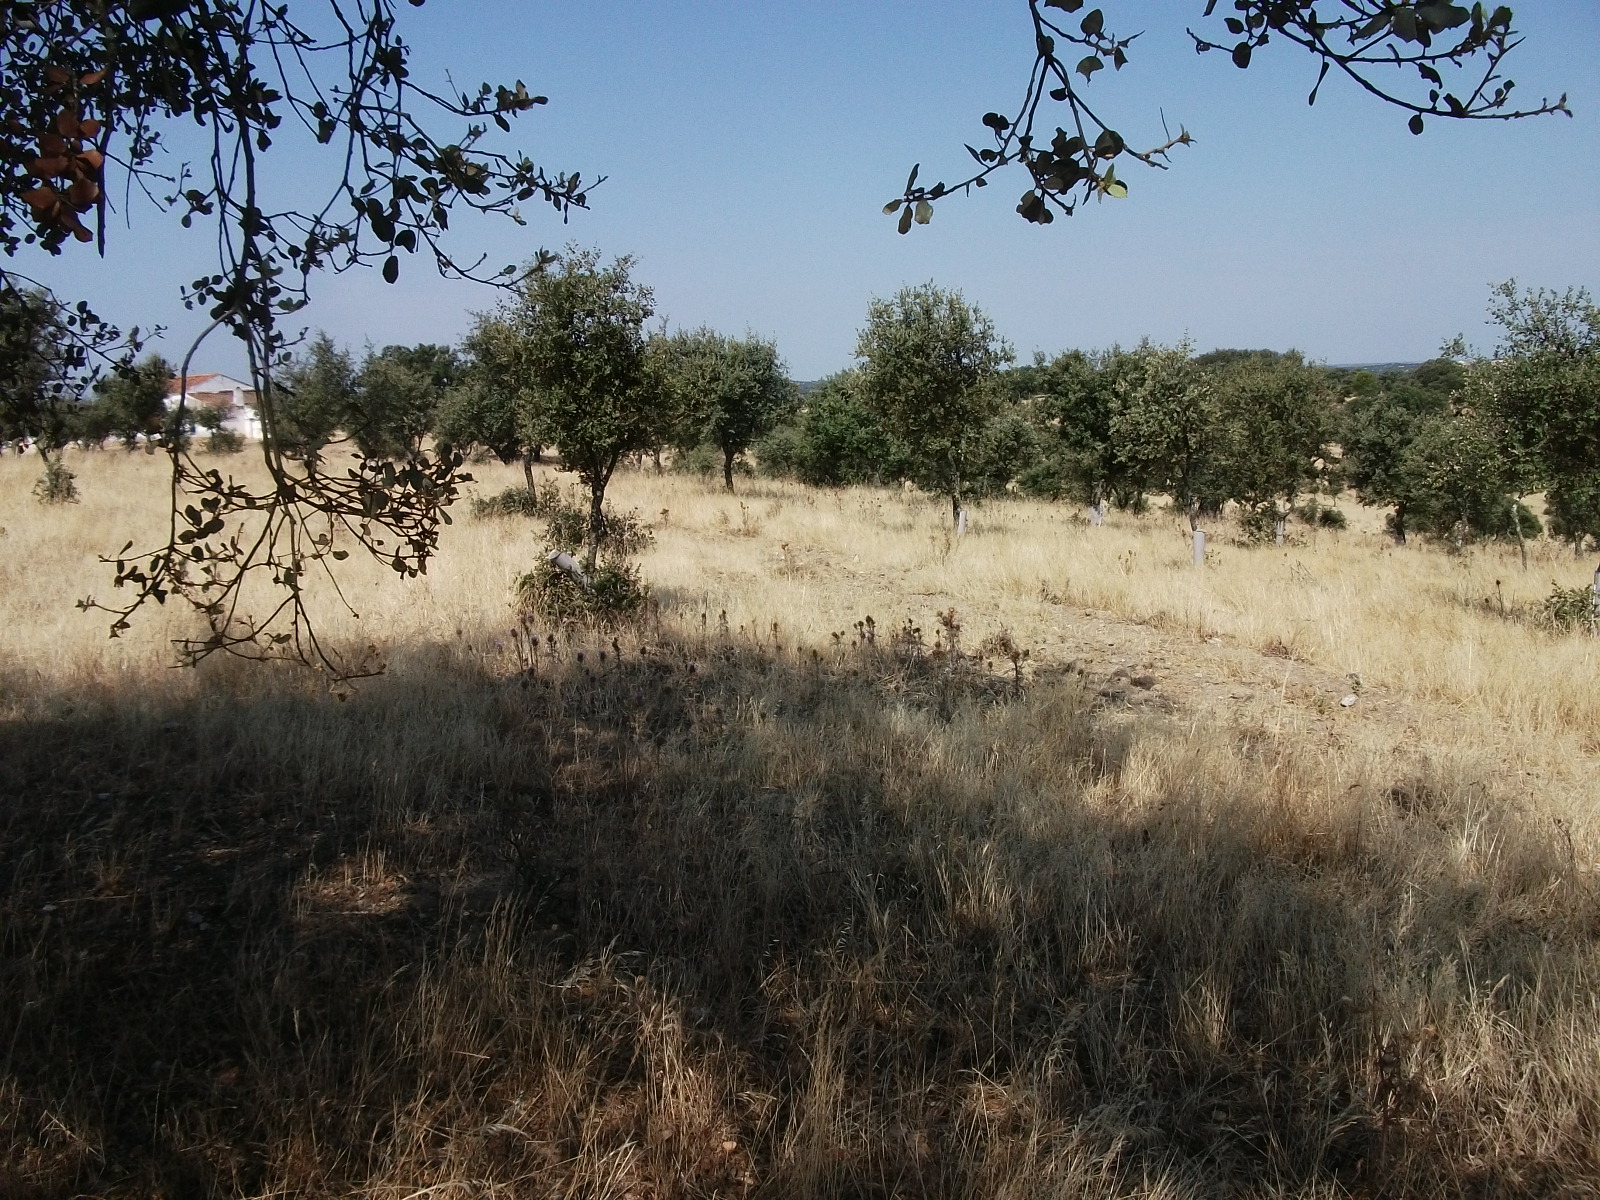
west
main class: Woodland
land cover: Broadleaved woodland
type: broadleaved evergreen forest
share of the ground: 25 - 50 %
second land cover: Spontaneously vegetated surfaces
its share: > 75 %
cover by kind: herbaceous plants 70 %, broadleaved forest trees 30 %
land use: Forestry
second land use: Agriculture (excluding fallow land and kitchen gardens)
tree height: > 5 m
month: June
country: ES
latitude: 37.6897
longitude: -7.1638
